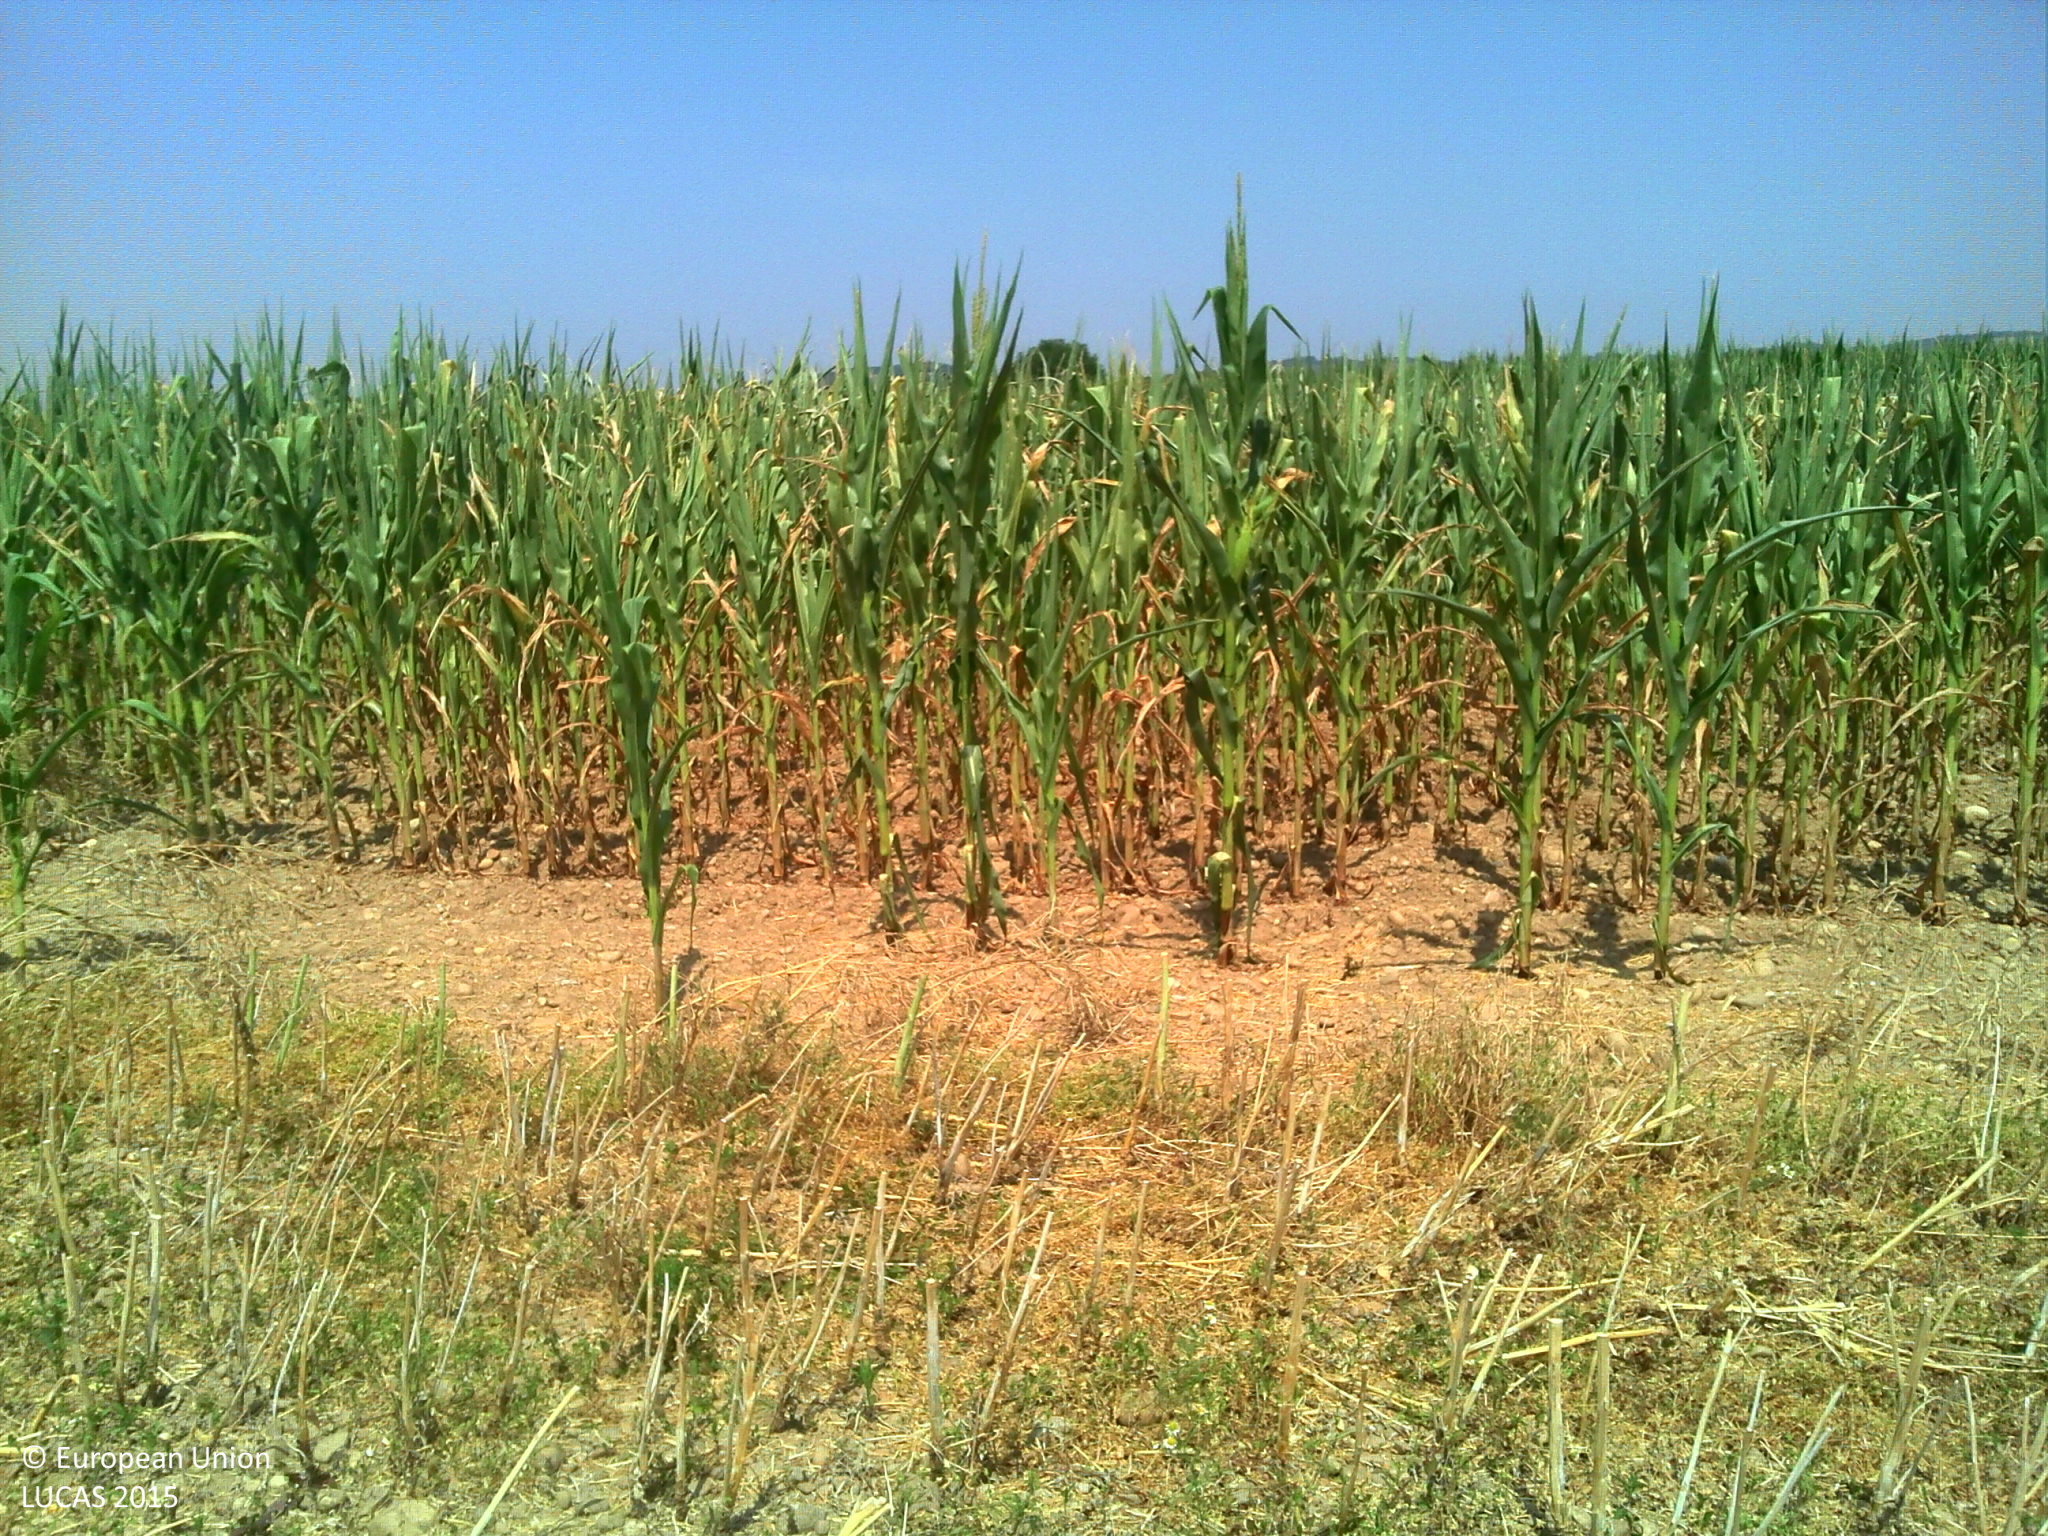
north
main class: Cropland
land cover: Rape and turnip rape
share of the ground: > 75 %
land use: Agriculture (excluding fallow land and kitchen gardens)
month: July
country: FR
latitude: 45.3588
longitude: 5.1921
